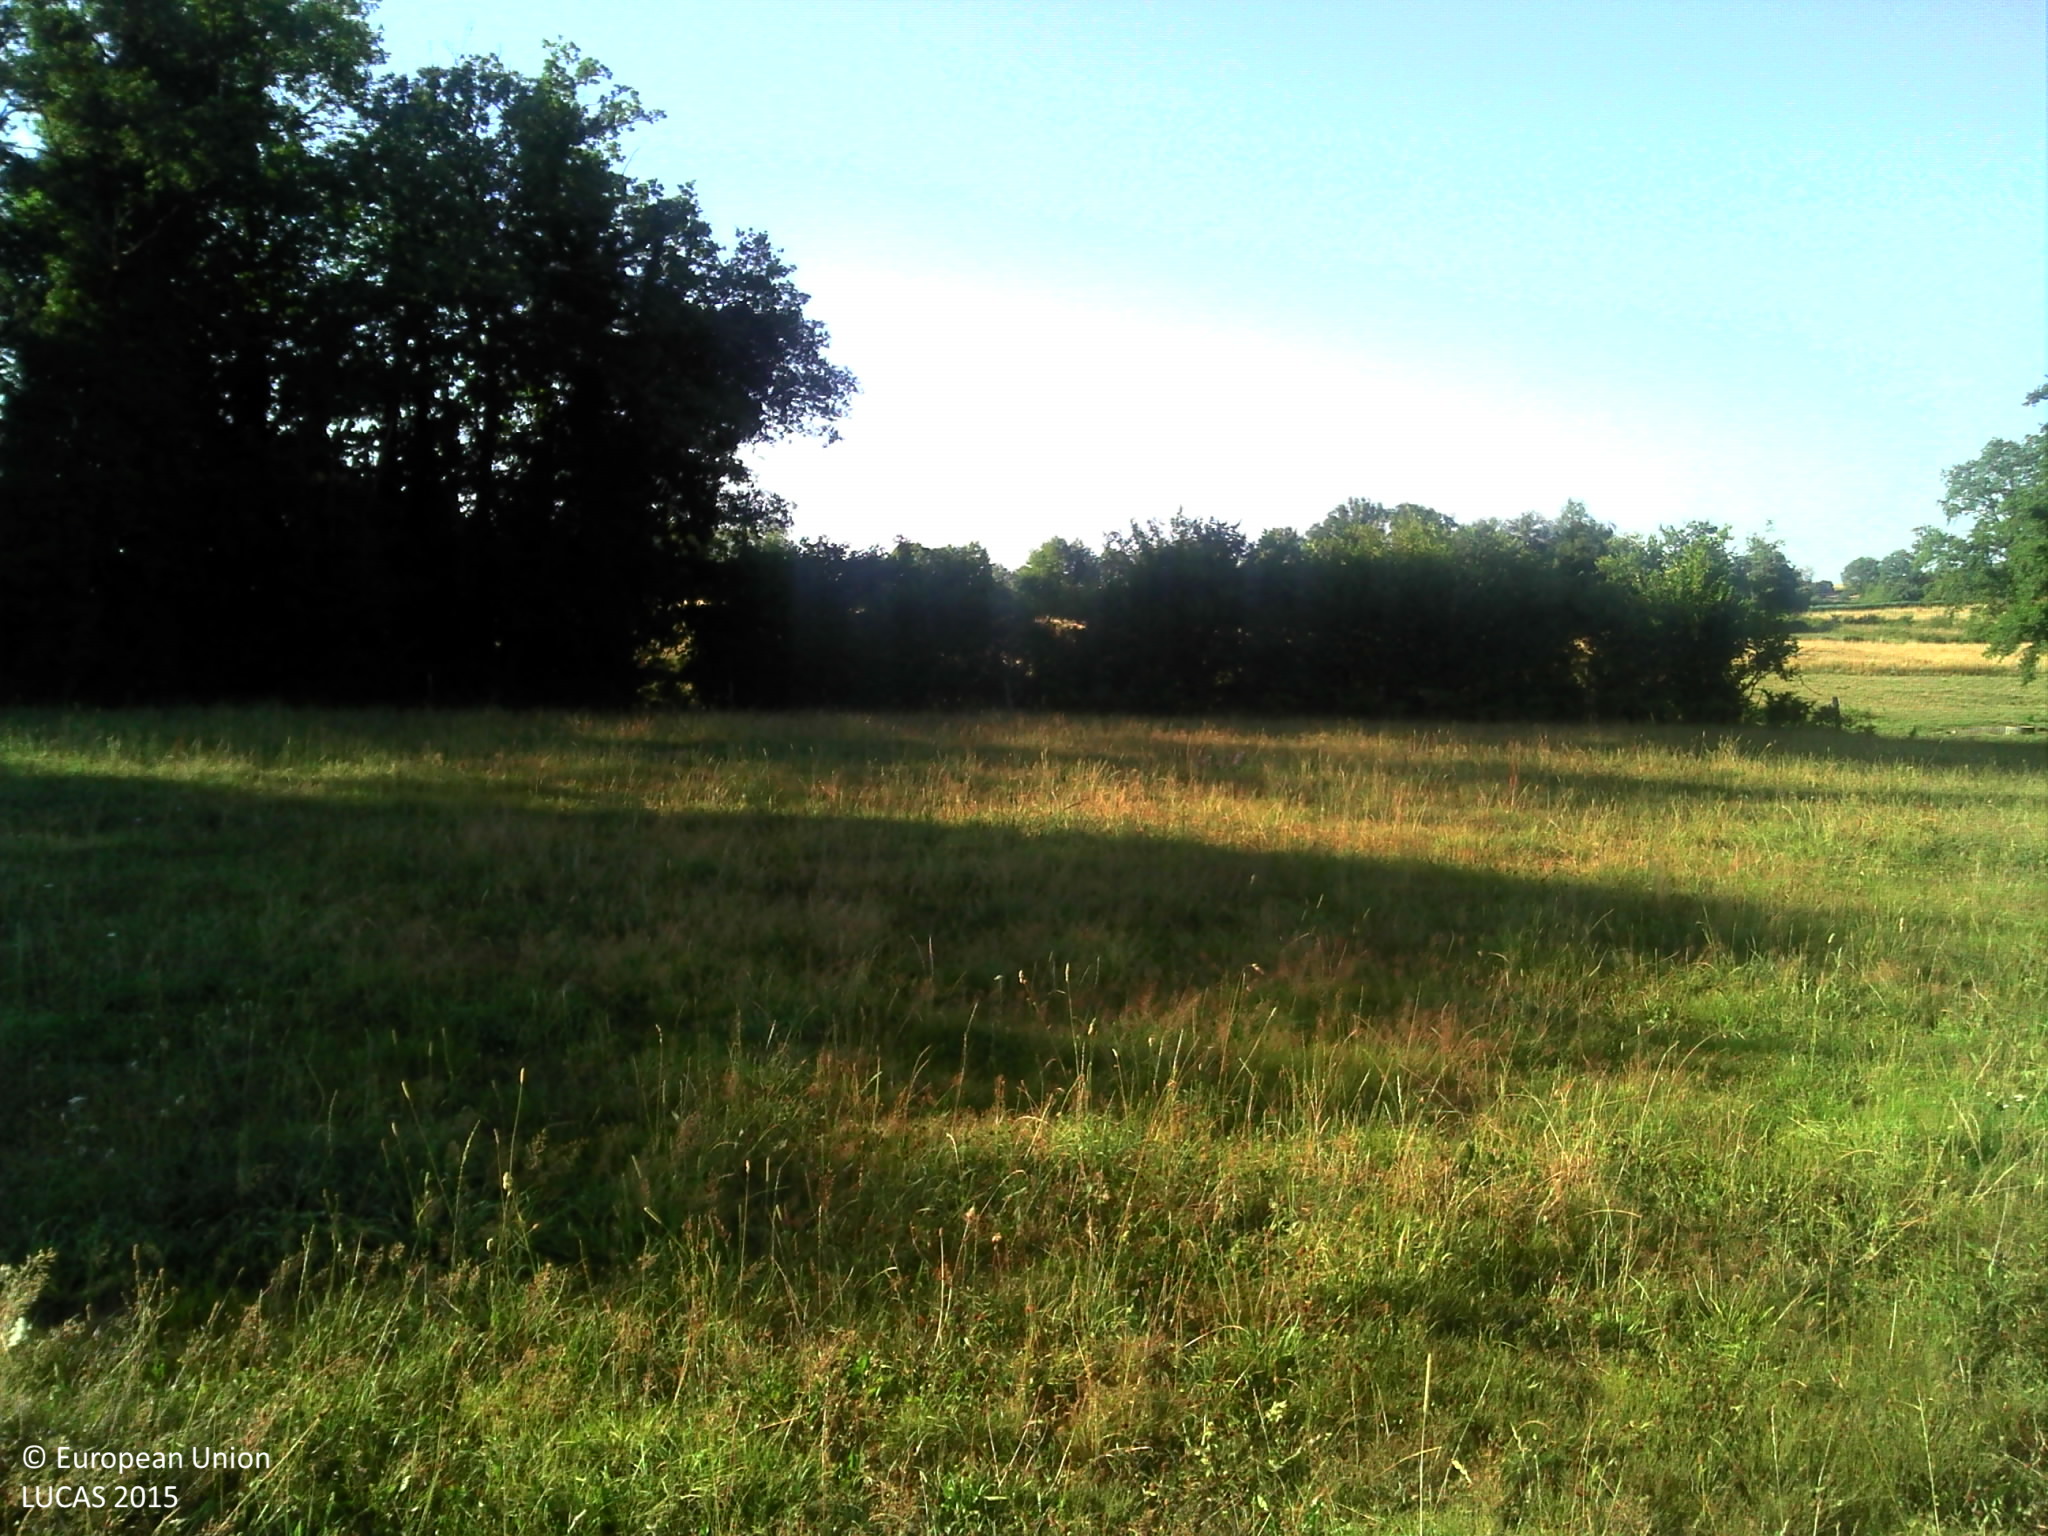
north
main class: Grassland
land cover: Grassland without tree/shrub cover
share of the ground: > 75 %
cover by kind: herbaceous plants 100 %
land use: Agriculture (excluding fallow land and kitchen gardens)
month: July
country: FR
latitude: 46.2397
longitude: 1.6267
